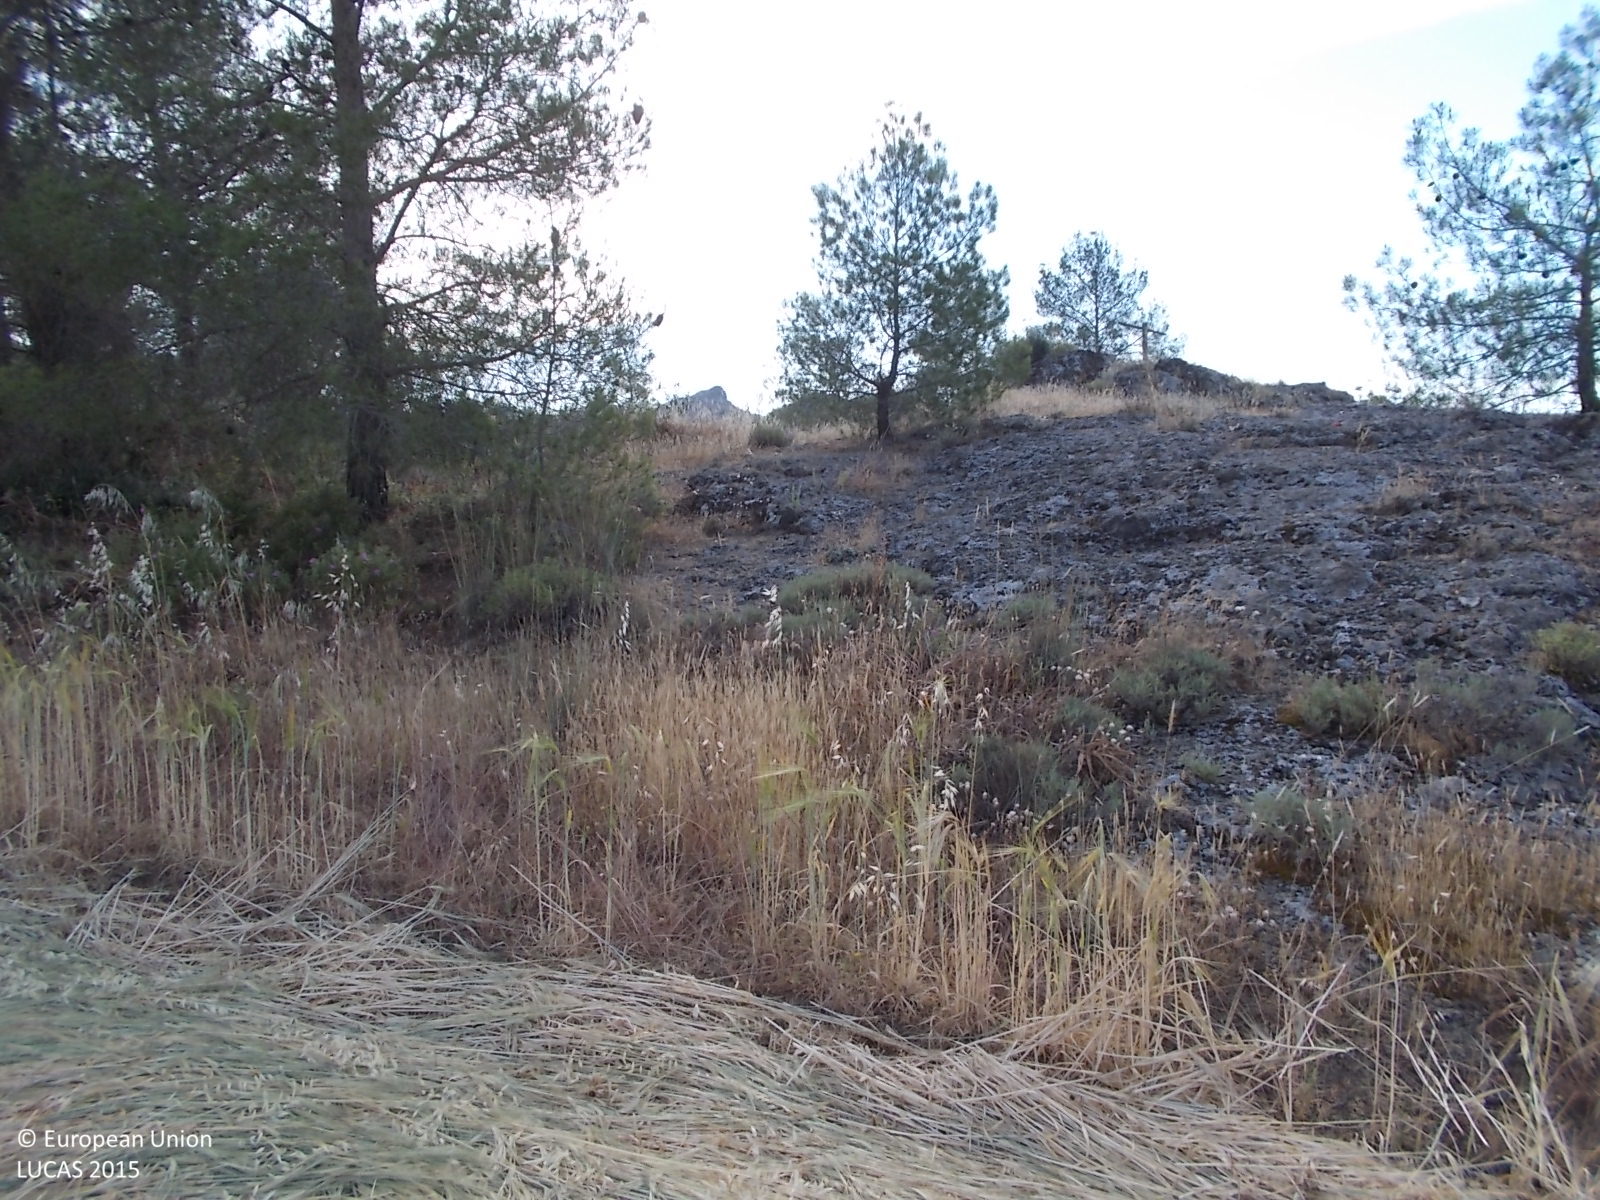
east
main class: Cropland
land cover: Mixed cereals for fodder
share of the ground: > 75 %
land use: Agriculture (excluding fallow land and kitchen gardens)
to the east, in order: Mixed cereals for fodder; Grass margins; Rock outcrops; Pine dominated coniferous woodland; Grassland with sparse tree/shrub cover; Mixed cereals for fodder; Pine dominated coniferous woodland; Rock outcrops; Rocks and stones; Single bushes/trees; Rocks and stones; Pine dominated coniferous woodland; Grassland with sparse tree/shrub cover; Lines of trees; Rock outcrops; Grass margins; Tracks; Pine dominated coniferous woodland; Grass margins; Paved roads, cycling and walking lanes; Pine dominated coniferous woodland; Rivers and streams; Pine dominated coniferous woodland
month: May
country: CY
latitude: 34.9089
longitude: 33.3547
